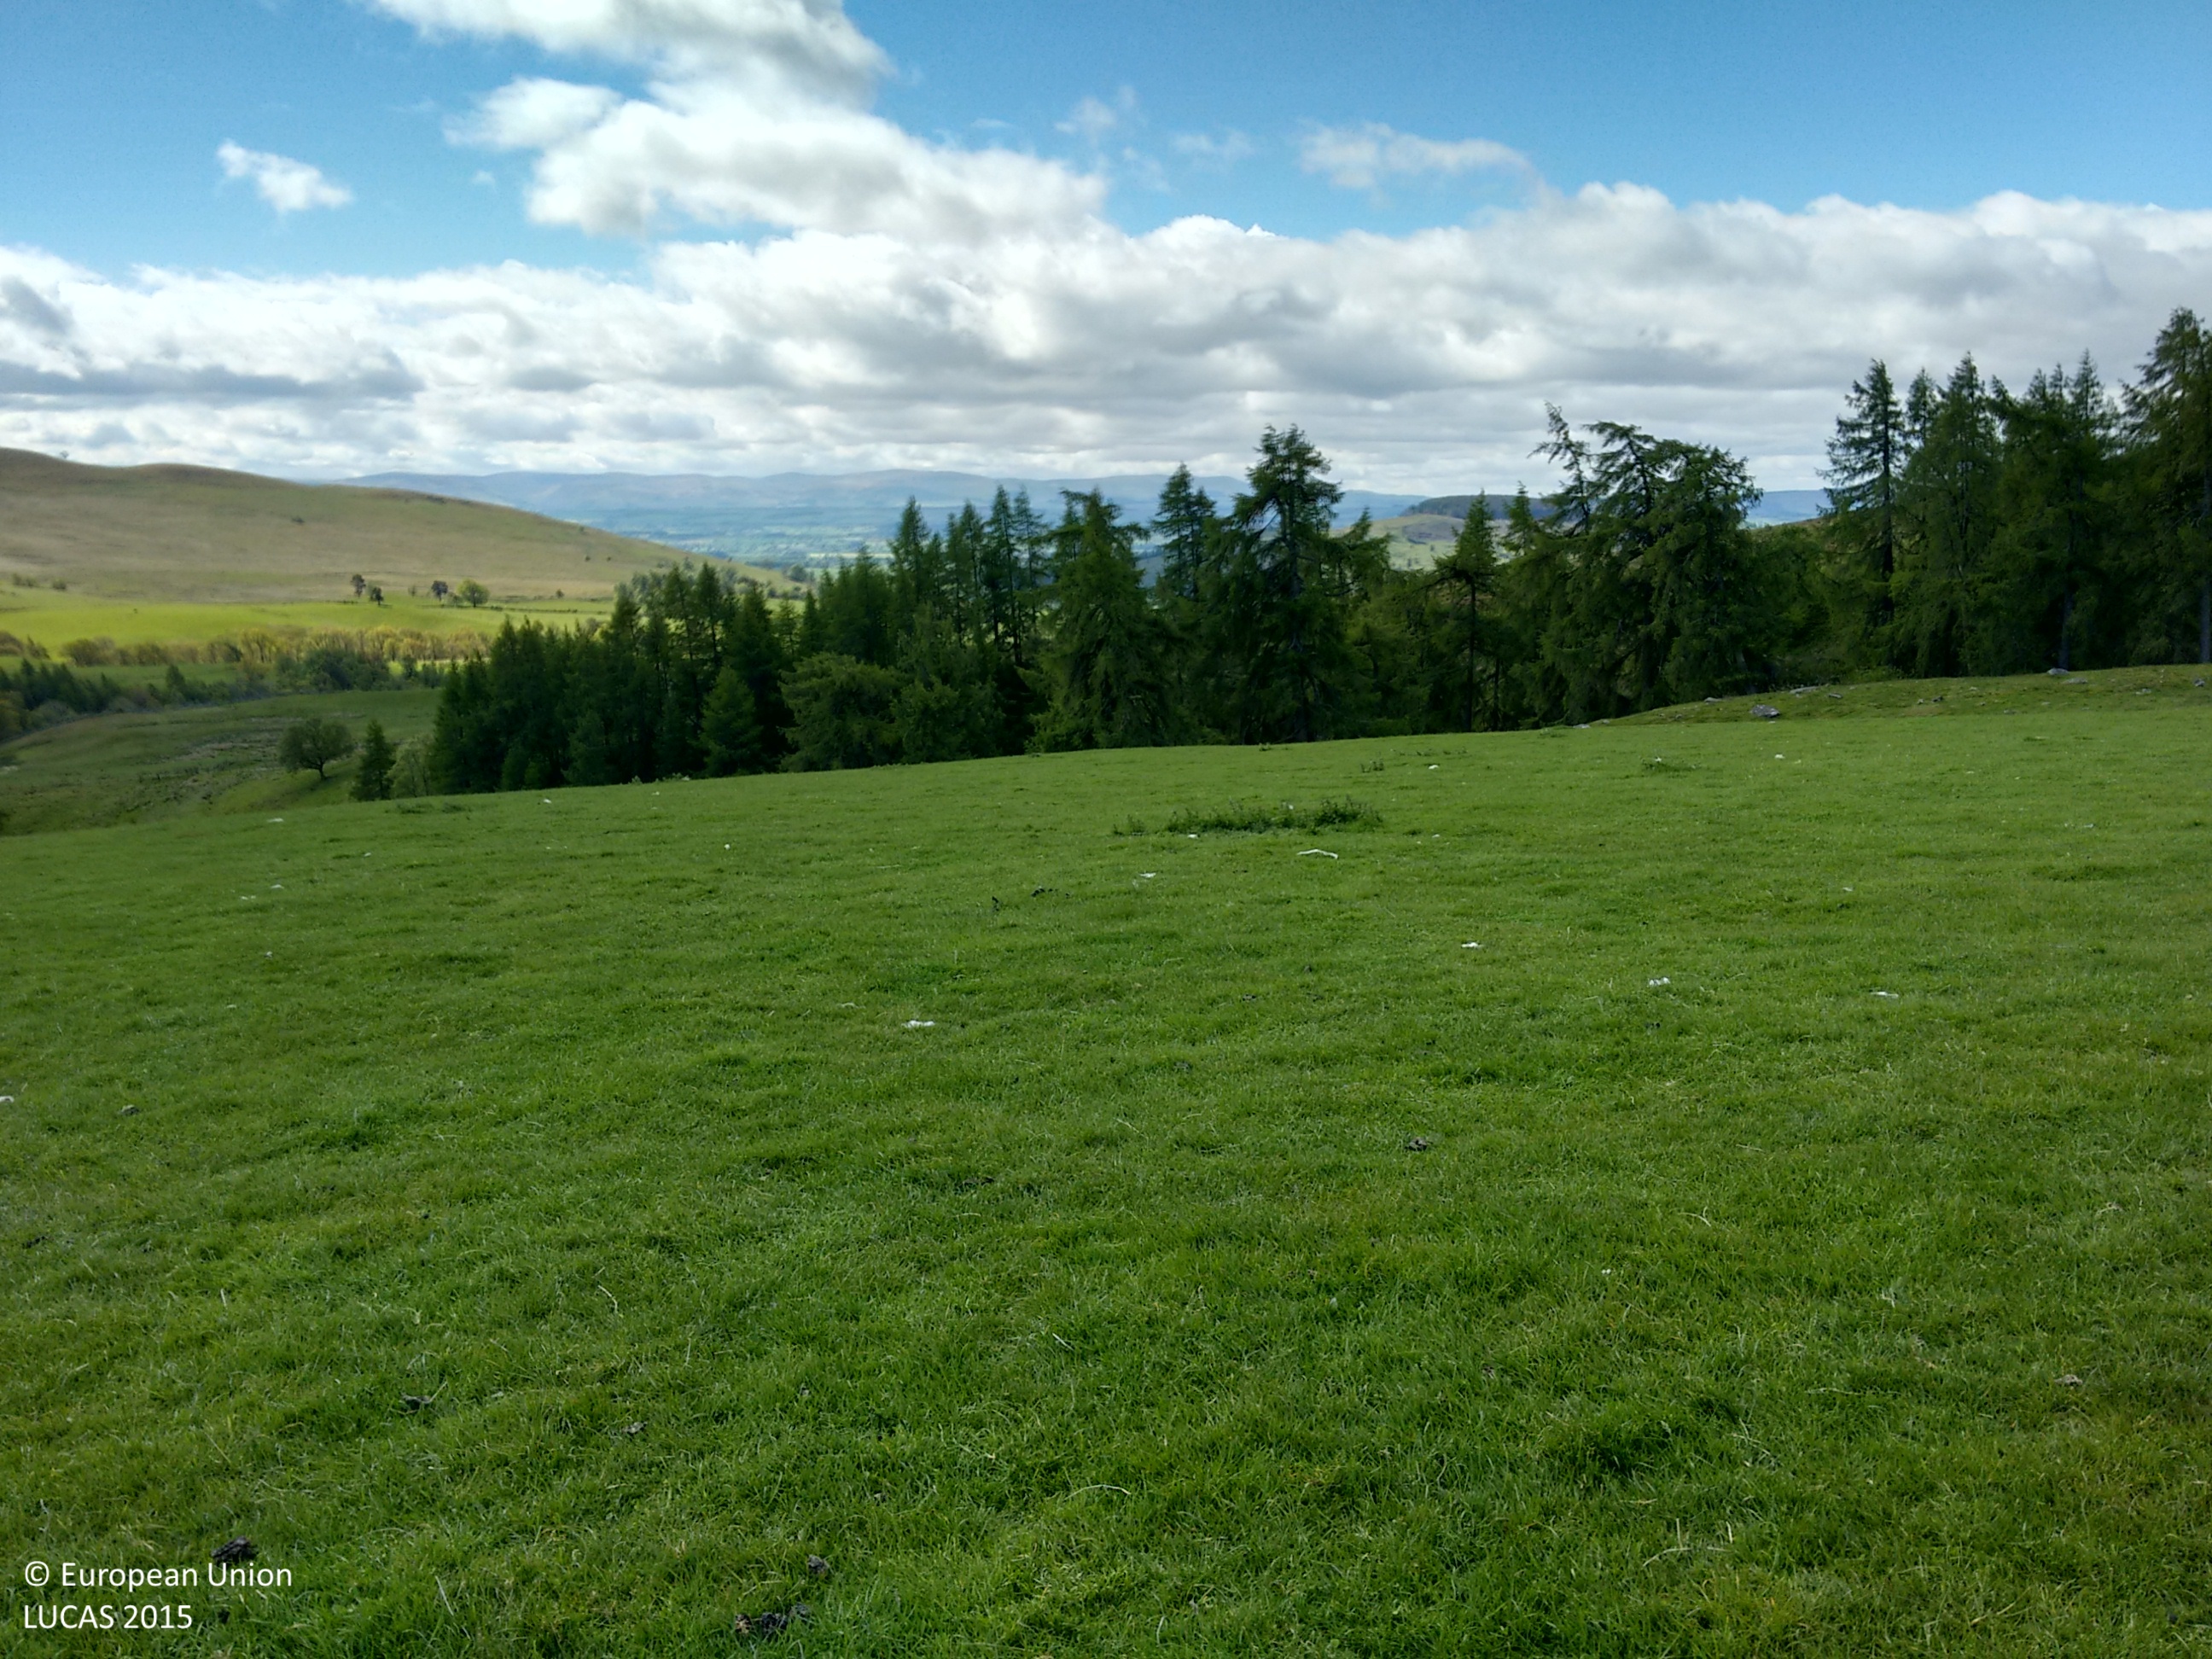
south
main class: Grassland
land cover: Grassland without tree/shrub cover
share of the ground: > 75 %
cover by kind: herbaceous plants 100 %
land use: Agriculture (excluding fallow land and kitchen gardens)
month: June
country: GB
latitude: 56.4226
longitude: -3.8134
